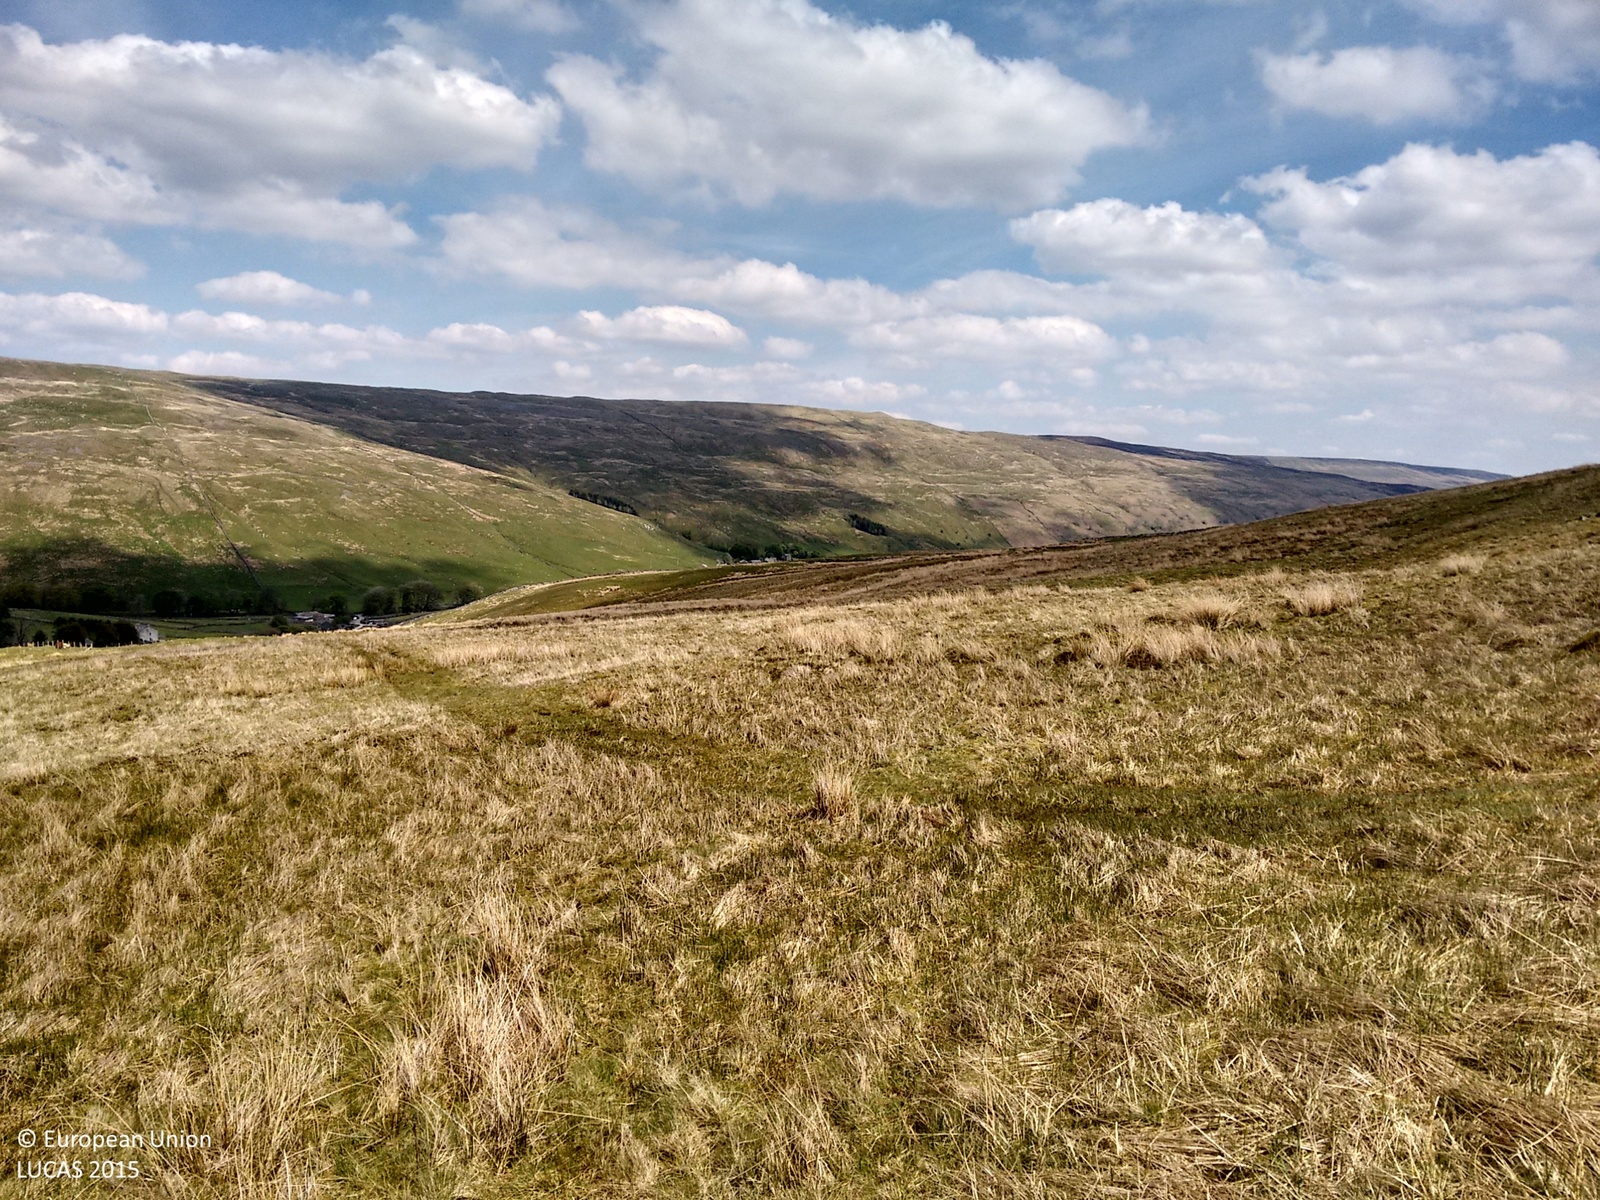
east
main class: Grassland
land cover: Grassland without tree/shrub cover
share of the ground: > 75 %
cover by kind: herbaceous plants 100 %
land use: Agriculture (excluding fallow land and kitchen gardens)
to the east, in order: Grassland without tree/shrub cover; Ditches and canals; Grassland without tree/shrub cover; Ditches and canals; Grassland without tree/shrub cover
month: June
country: GB
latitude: 54.1822
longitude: -2.2106
